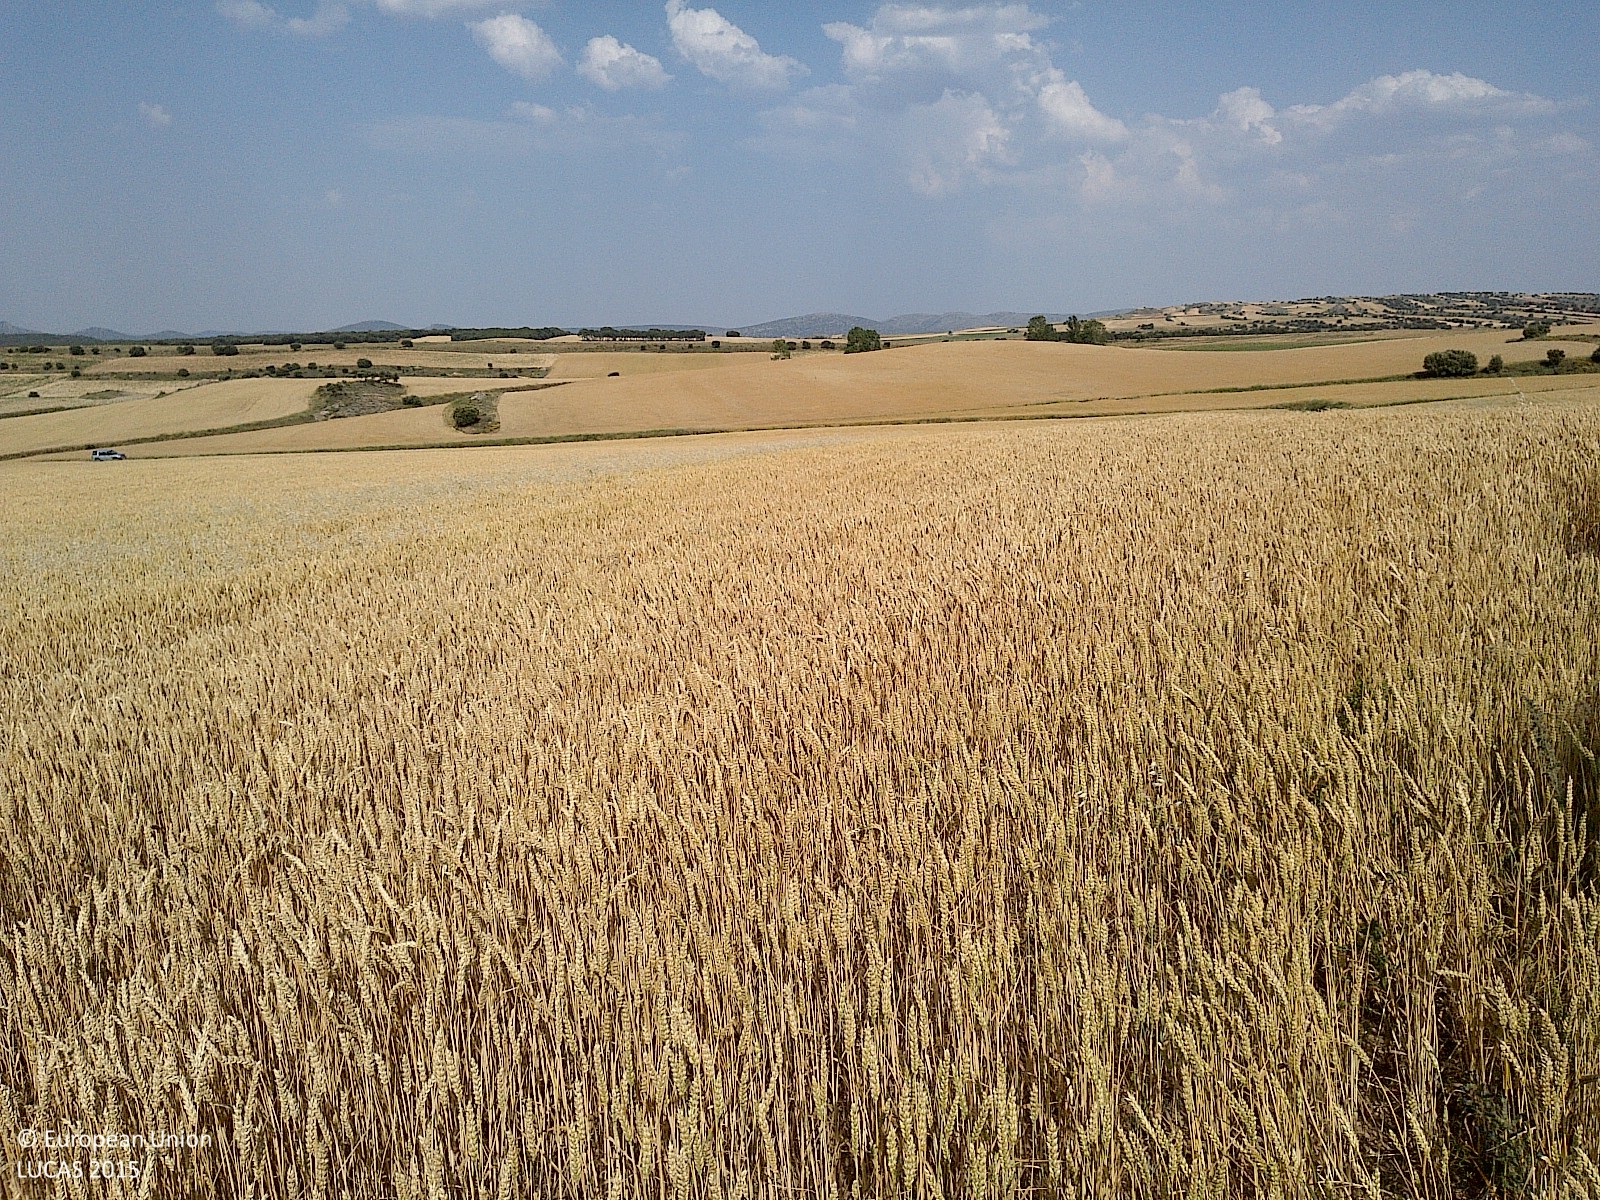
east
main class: Cropland
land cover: Common wheat
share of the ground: > 75 %
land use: Agriculture (excluding fallow land and kitchen gardens)
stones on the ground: < 10 %
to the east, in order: Common wheat; Spontaneously vegetated surfaces; Tracks; Grass margins; Durum wheat
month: June
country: ES
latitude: 41.5634
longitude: -2.2282
